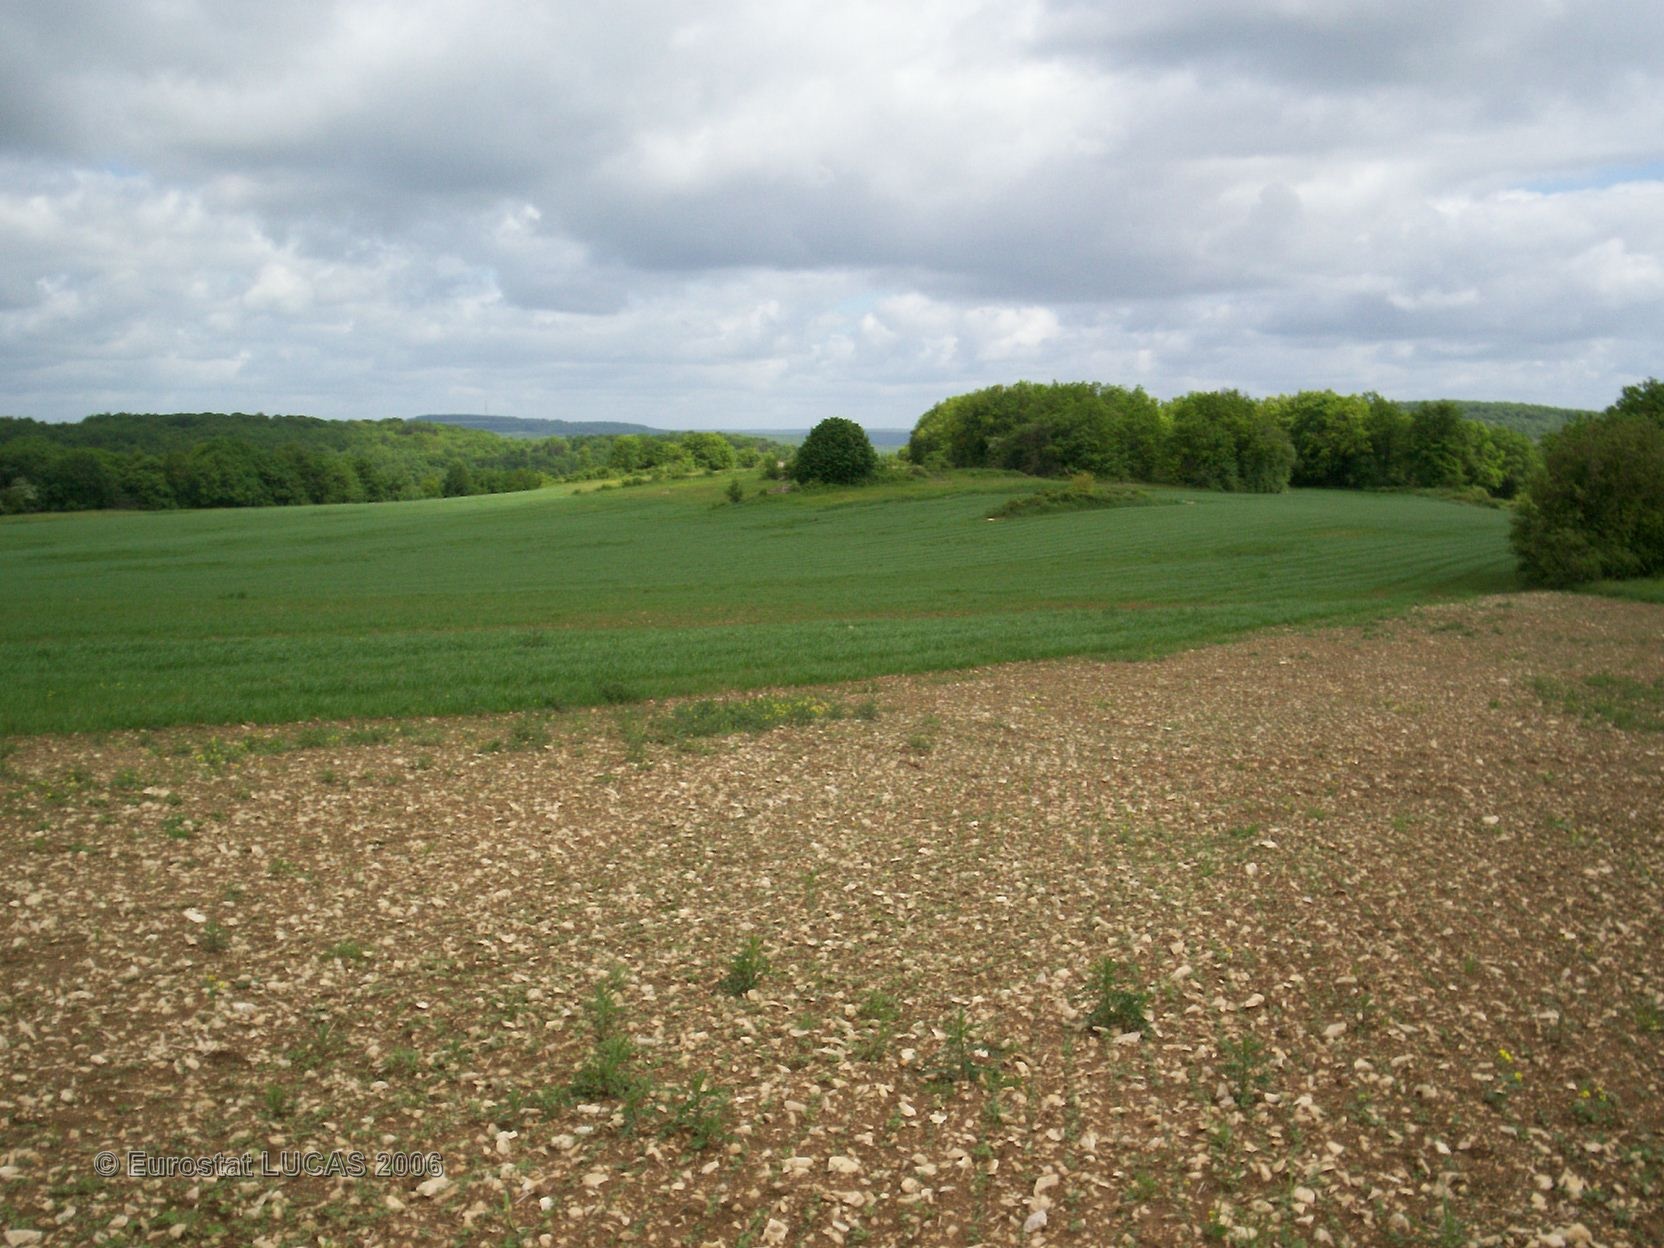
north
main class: Cropland
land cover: Clovers
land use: Fallow land
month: May
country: FR
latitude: 47.0843
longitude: 4.6657
